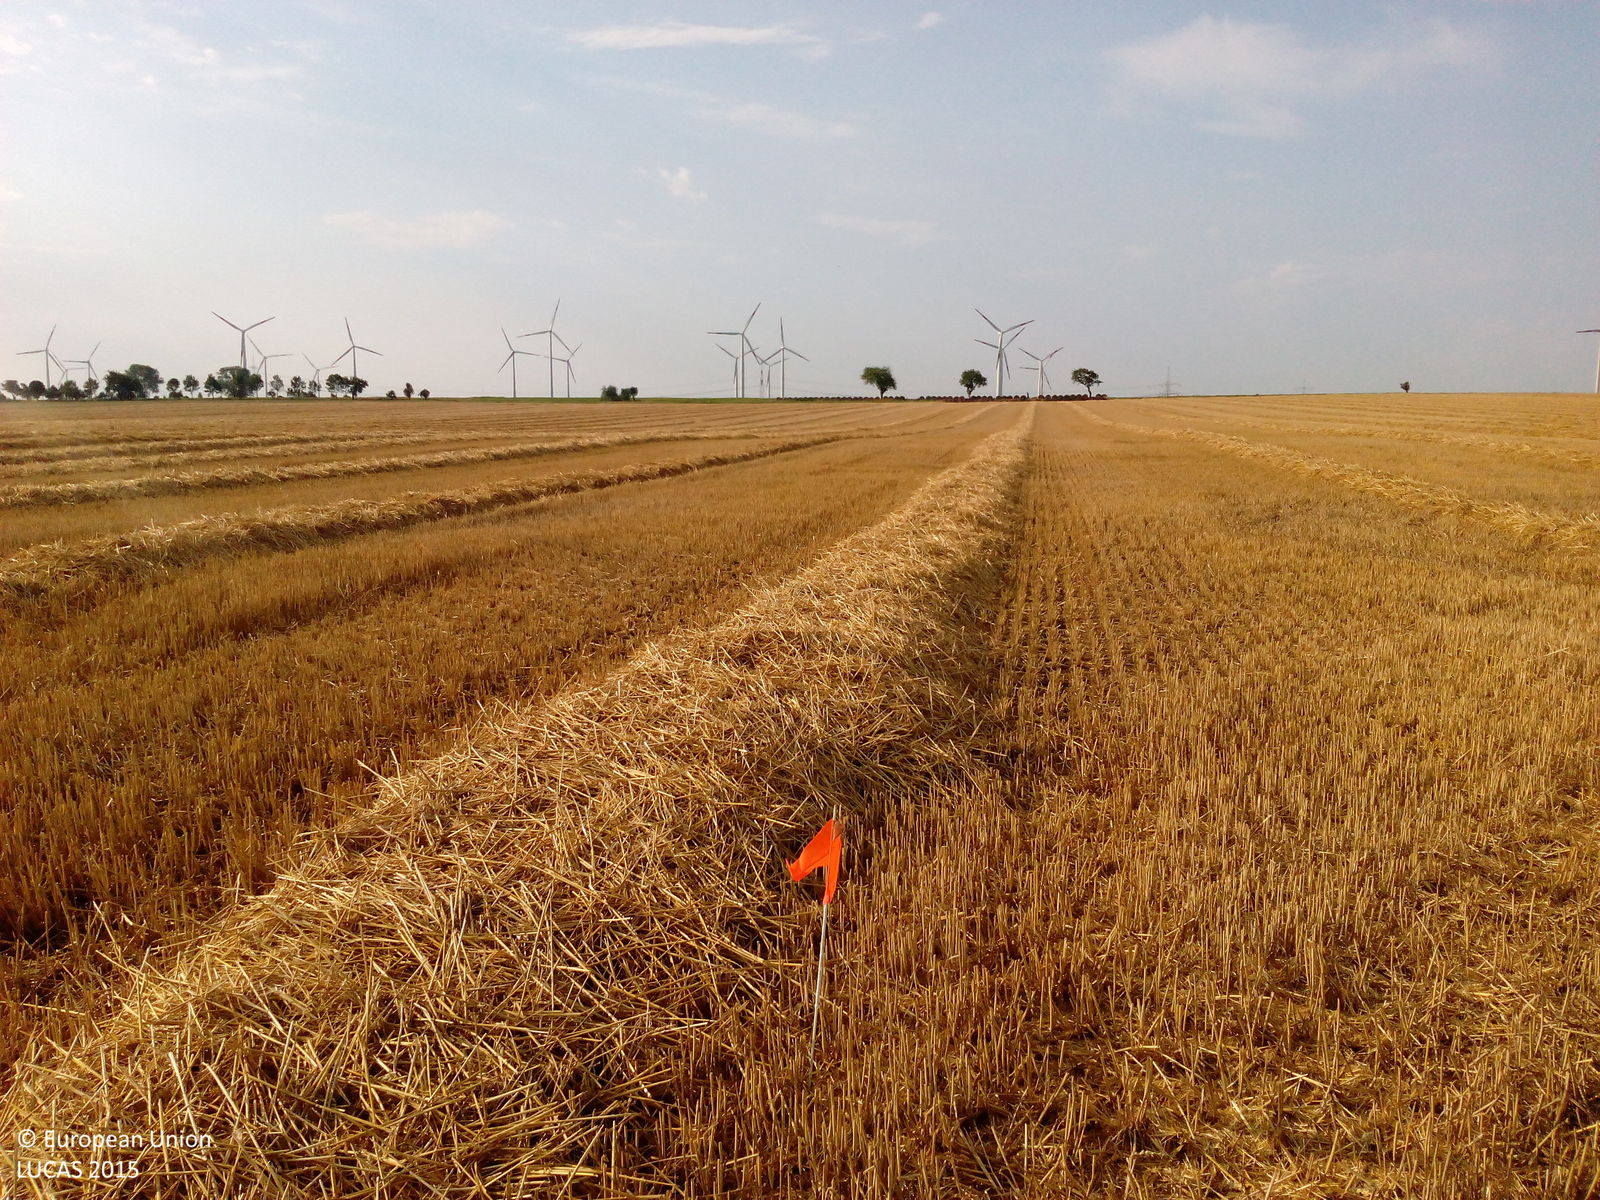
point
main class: Cropland
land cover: Common wheat
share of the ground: > 75 %
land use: Agriculture (excluding fallow land and kitchen gardens)
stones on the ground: < 10 %
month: August
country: DE
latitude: 52.0127
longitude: 11.1215
